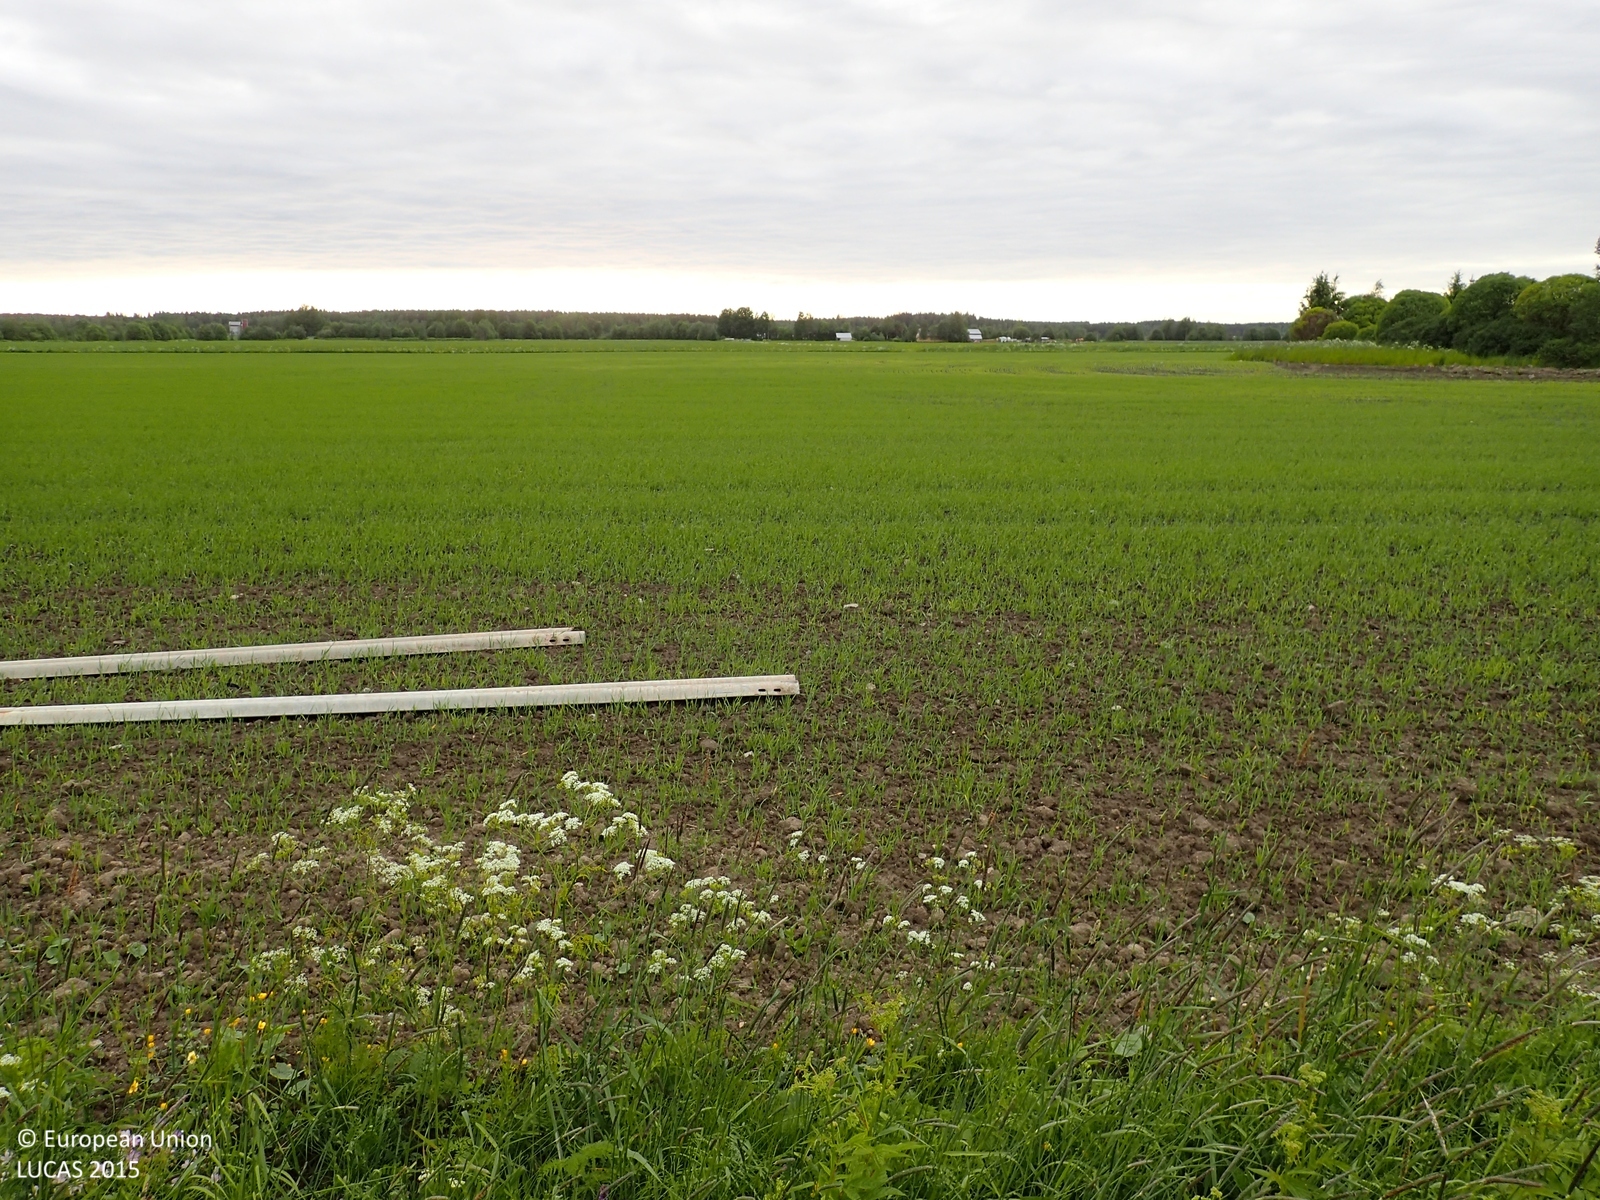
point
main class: Cropland
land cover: Barley
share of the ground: > 75 %
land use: Agriculture (excluding fallow land and kitchen gardens)
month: June
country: FI
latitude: 62.3292
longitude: 21.5689
